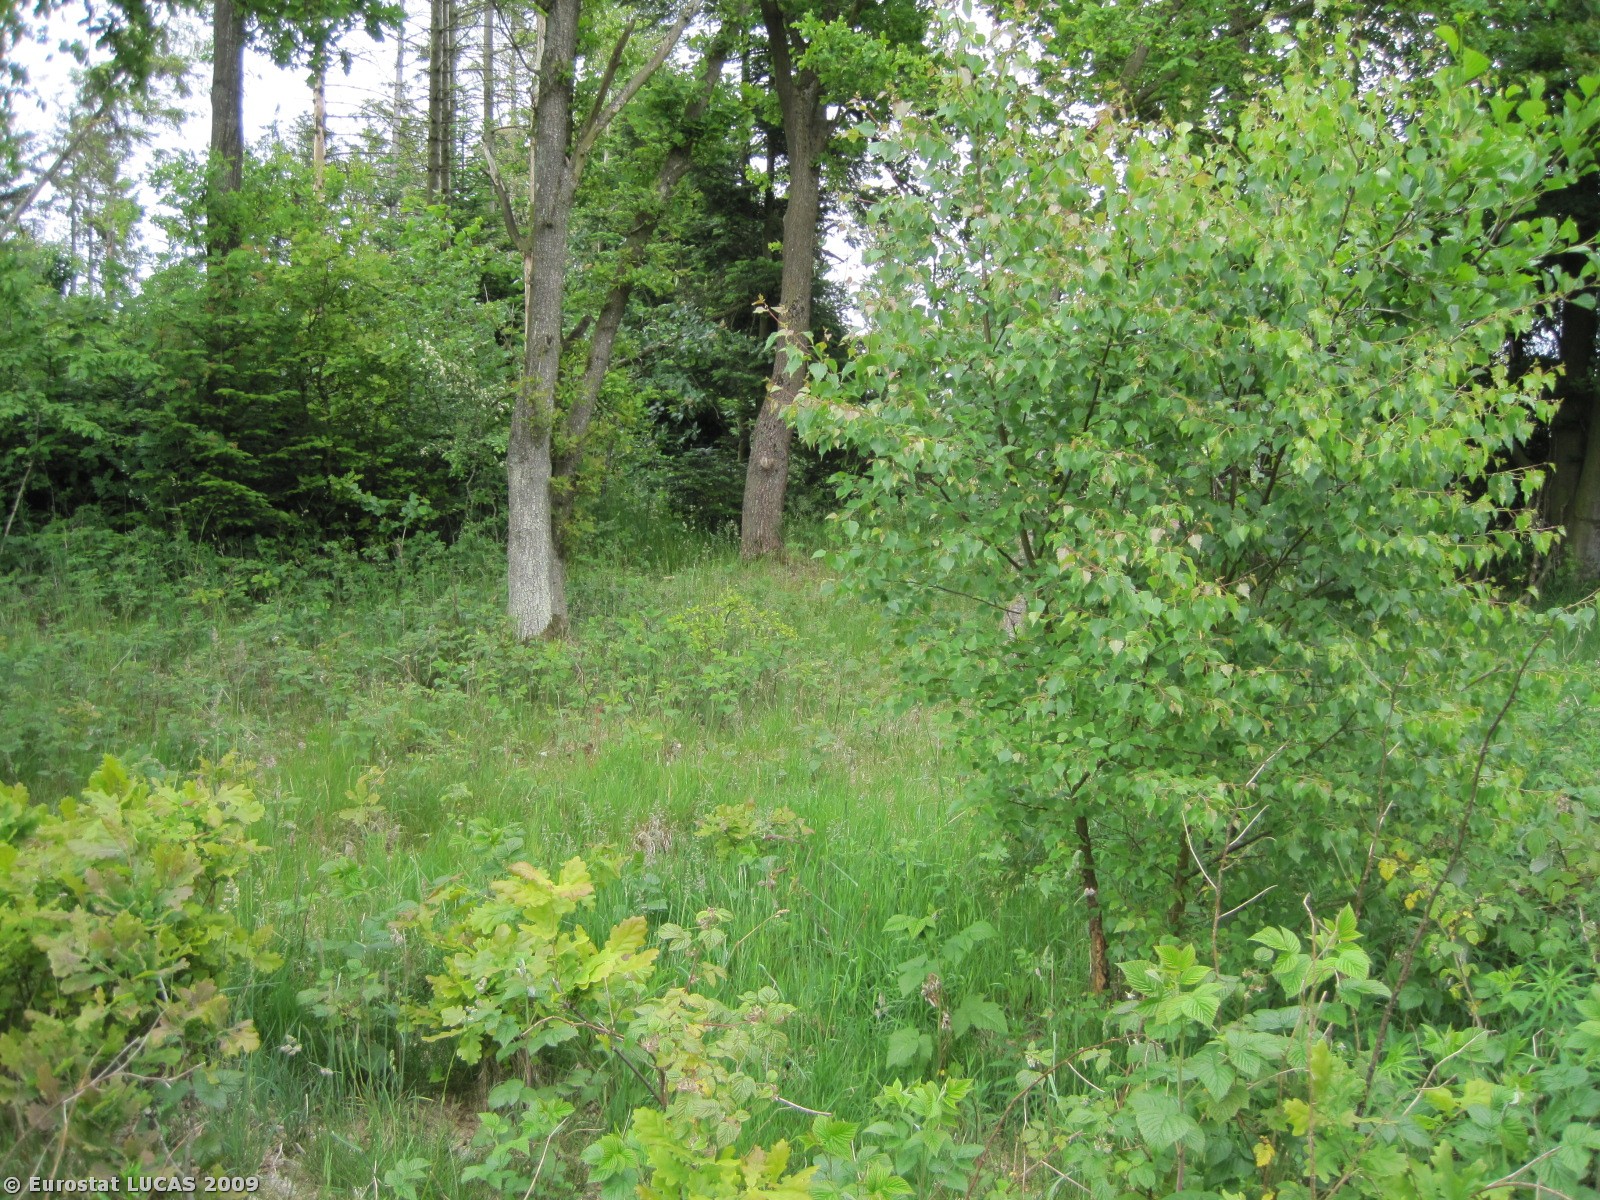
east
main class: Shrubland
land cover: Shrubland with sparse tree cover
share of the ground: > 75 %
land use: Unused
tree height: < 5 m
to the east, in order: Shrubland with sparse tree cover; Grassland with sparse tree/shrub cover; Mixed woodland; Grassland without tree/shrub cover; Broadleaved woodland; Grass margins; Barley; Electric lines; Grassland without tree/shrub cover
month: June
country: DK
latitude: 57.3563
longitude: 10.0166
